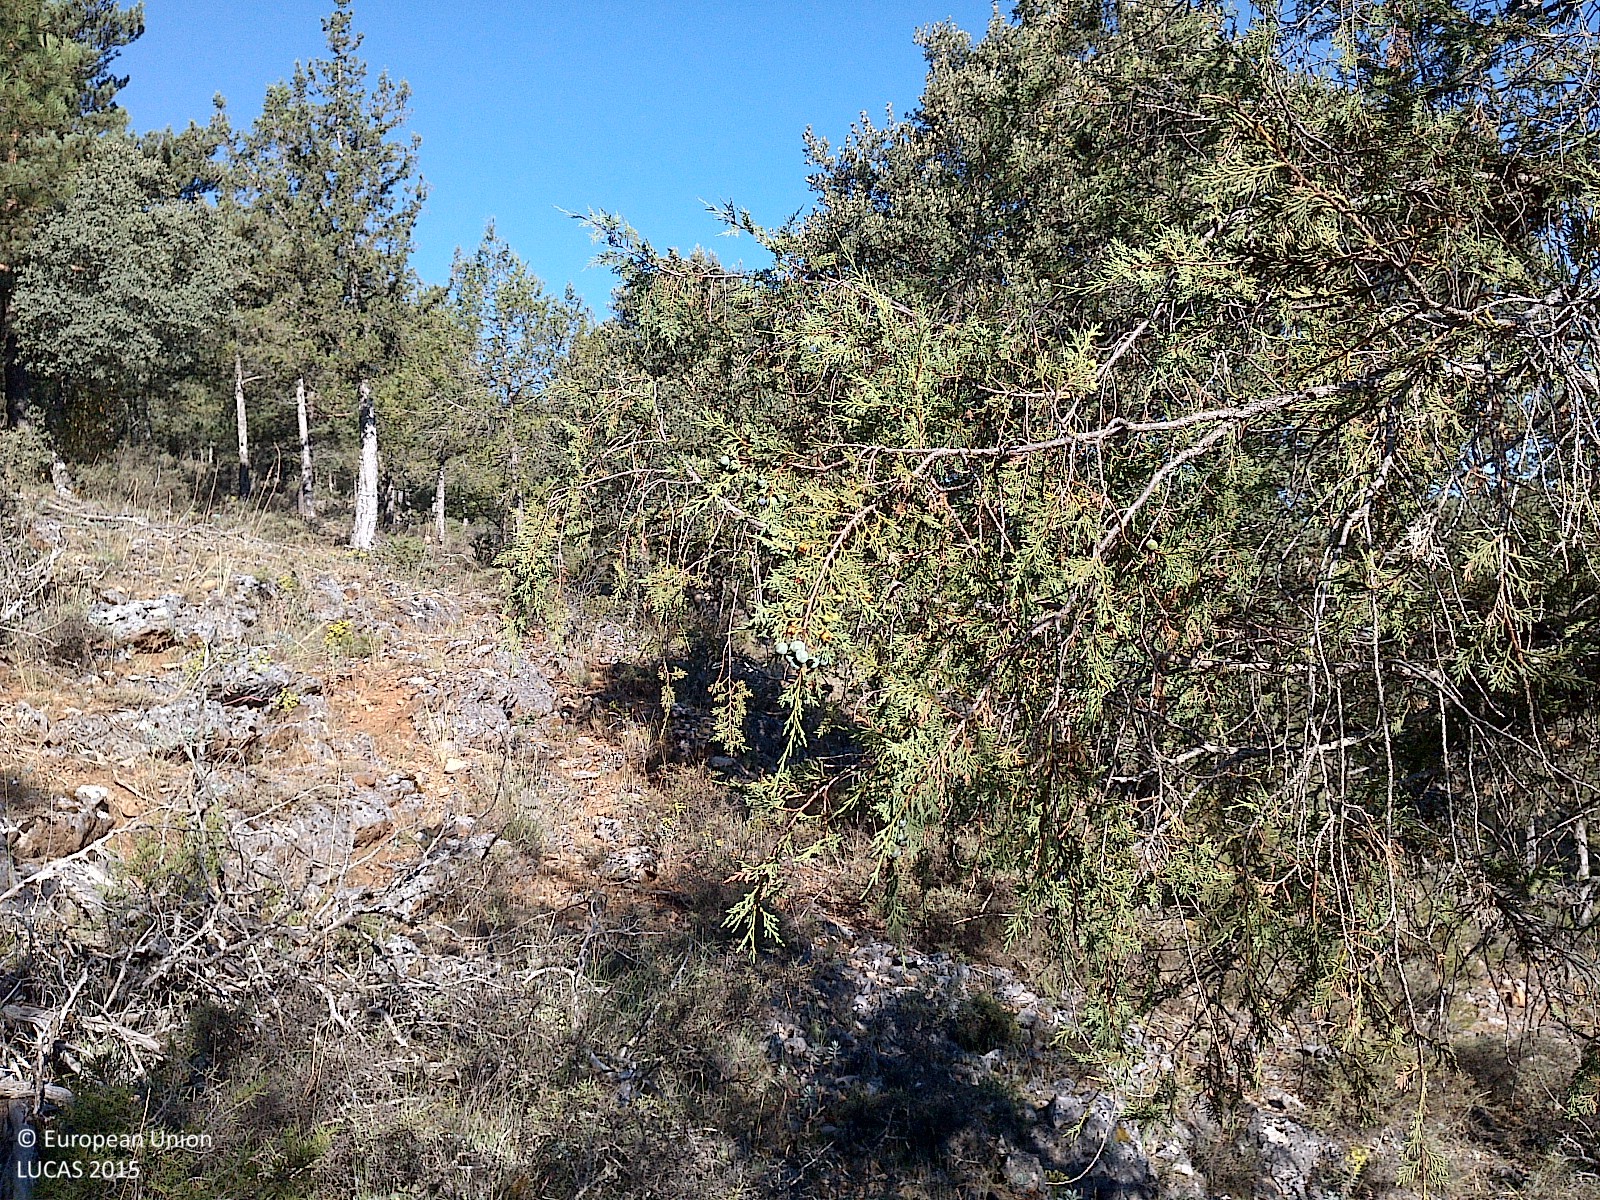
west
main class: Woodland
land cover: Other coniferous woodland
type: coniferous forest of the mediterranean region
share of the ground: 25 - 50 %
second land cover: Shrubland without tree cover
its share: 10 - 25 %
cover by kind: consolidated bare surface 30 %, coniferous forest trees 25 %, herbaceous plants 20 %, shrubs 15 %, broadleaved forest trees 5 %, unconsolidated bare surface 5 %
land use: Forestry
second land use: Agriculture (excluding fallow land and kitchen gardens)
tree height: < 5 m
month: July
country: ES
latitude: 41.8049
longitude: -3.0566
